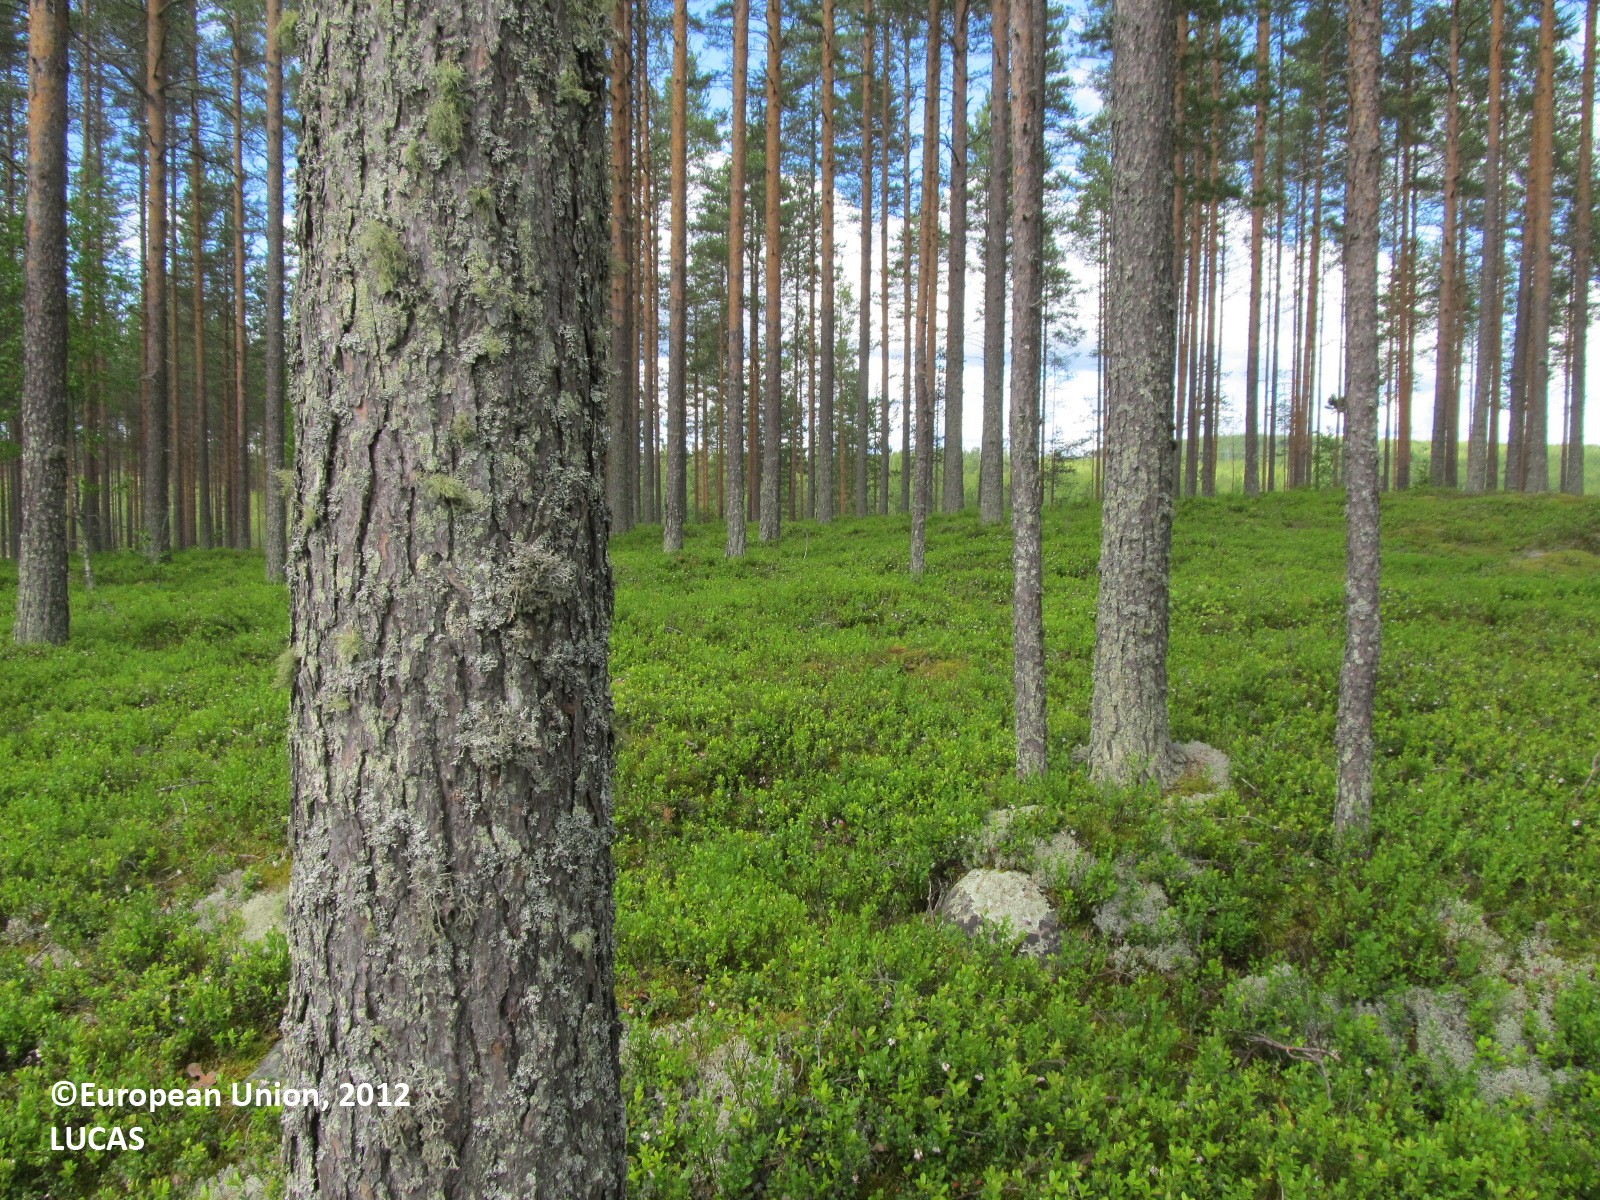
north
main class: Woodland
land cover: Pine dominated coniferous woodland
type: boreal forest
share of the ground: 50 - 75 %
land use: Forestry
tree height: > 5 m
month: June
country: FI
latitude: 62.9141
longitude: 28.8519
